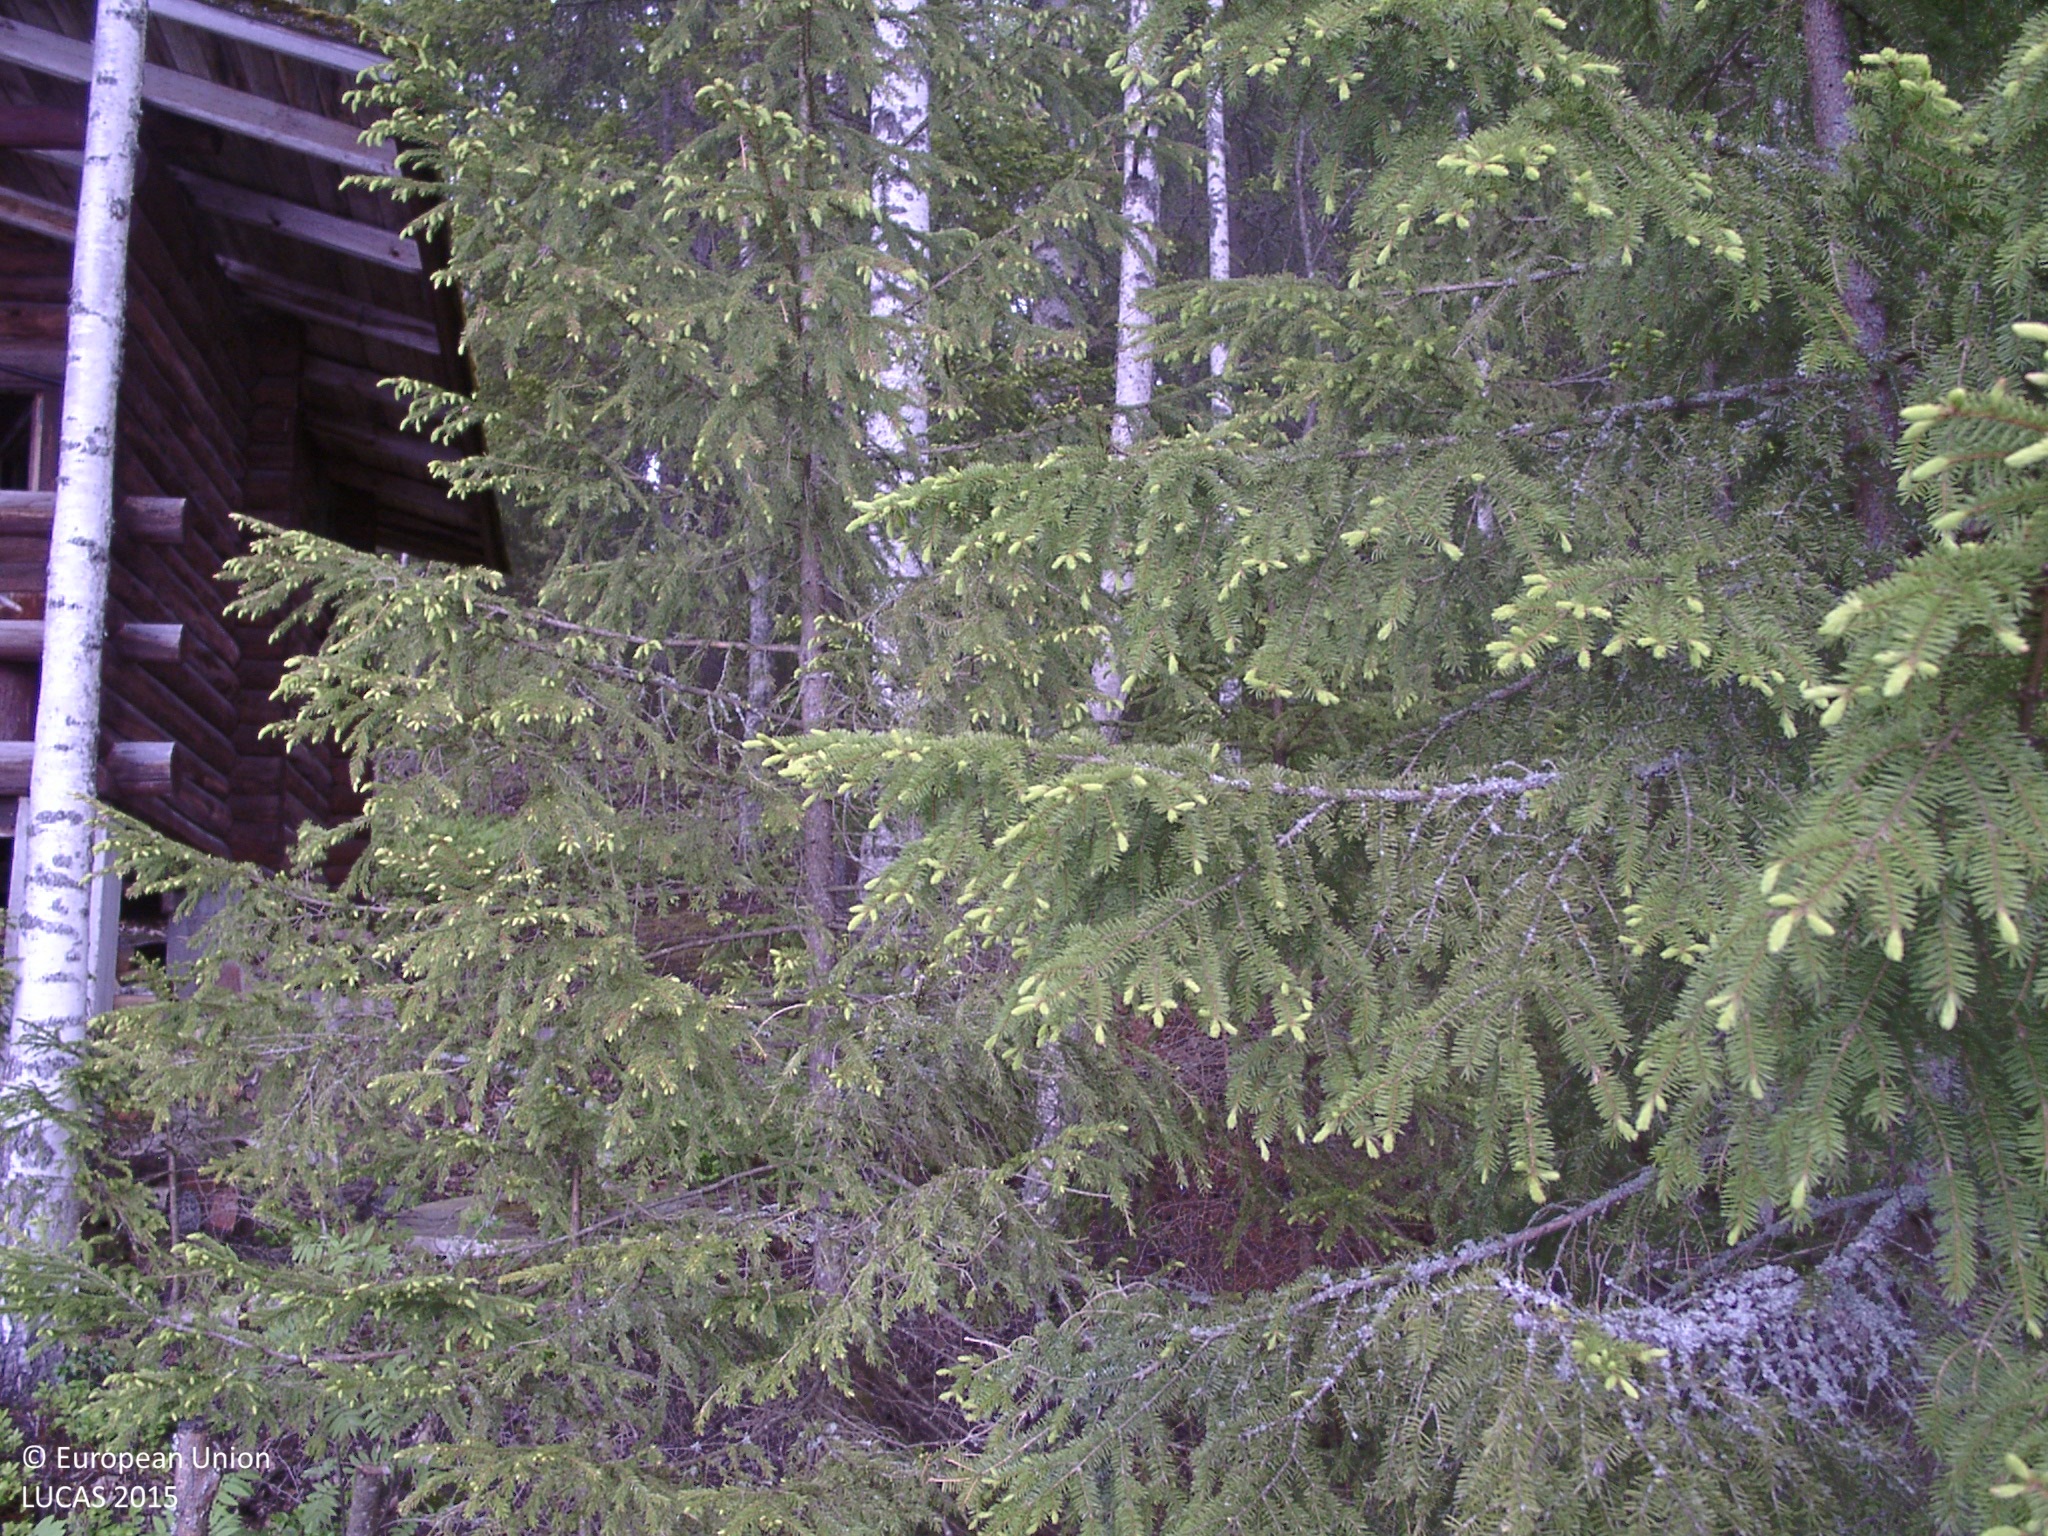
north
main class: Woodland
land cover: Other mixed woodland
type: boreal forest
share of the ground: 50 - 75 %
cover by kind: coniferous forest trees 35 %, shrubs 35 %, broadleaved forest trees 25 %, herbaceous plants 5 %
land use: Amenities, museums, leisure
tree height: > 5 m
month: June
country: FI
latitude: 62.2106
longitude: 25.4761
